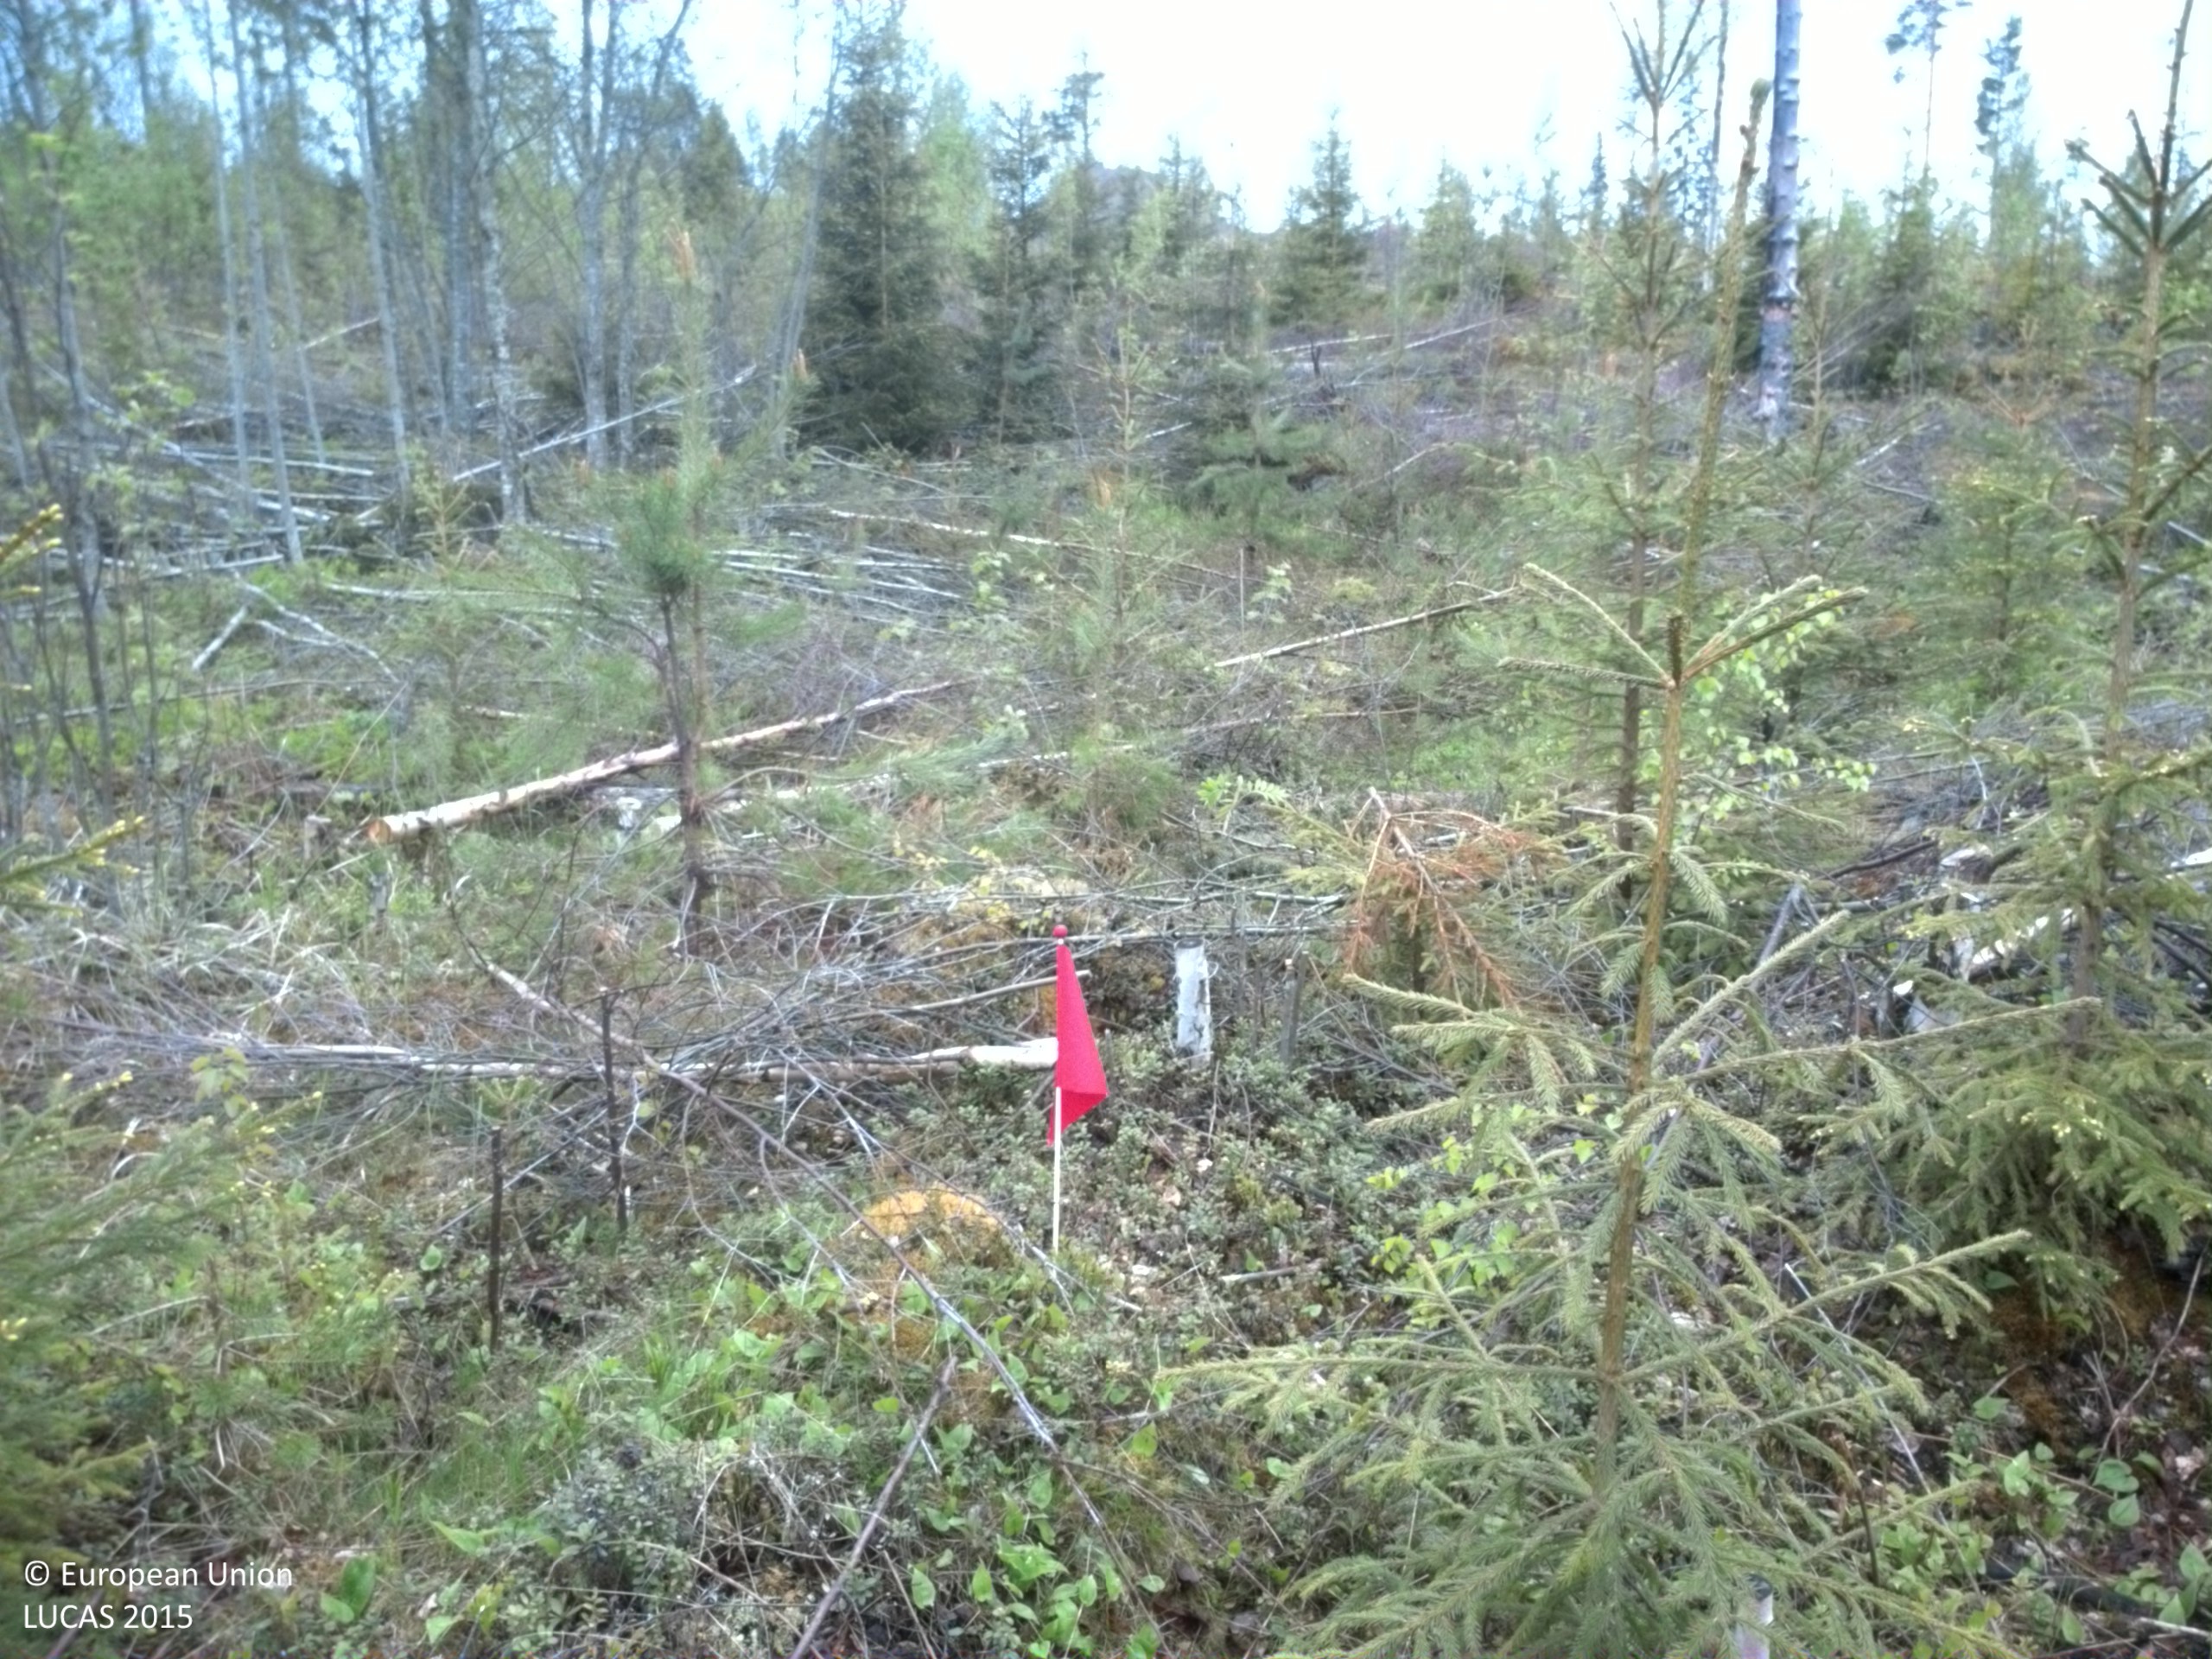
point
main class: Woodland
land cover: Other mixed woodland
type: boreal forest
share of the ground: > 75 %
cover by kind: coniferous forest trees 55 %, broadleaved forest trees 30 %, shrubs 15 %
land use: Forestry
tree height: < 5 m
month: June
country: SE
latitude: 63.1406
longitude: 16.9393
